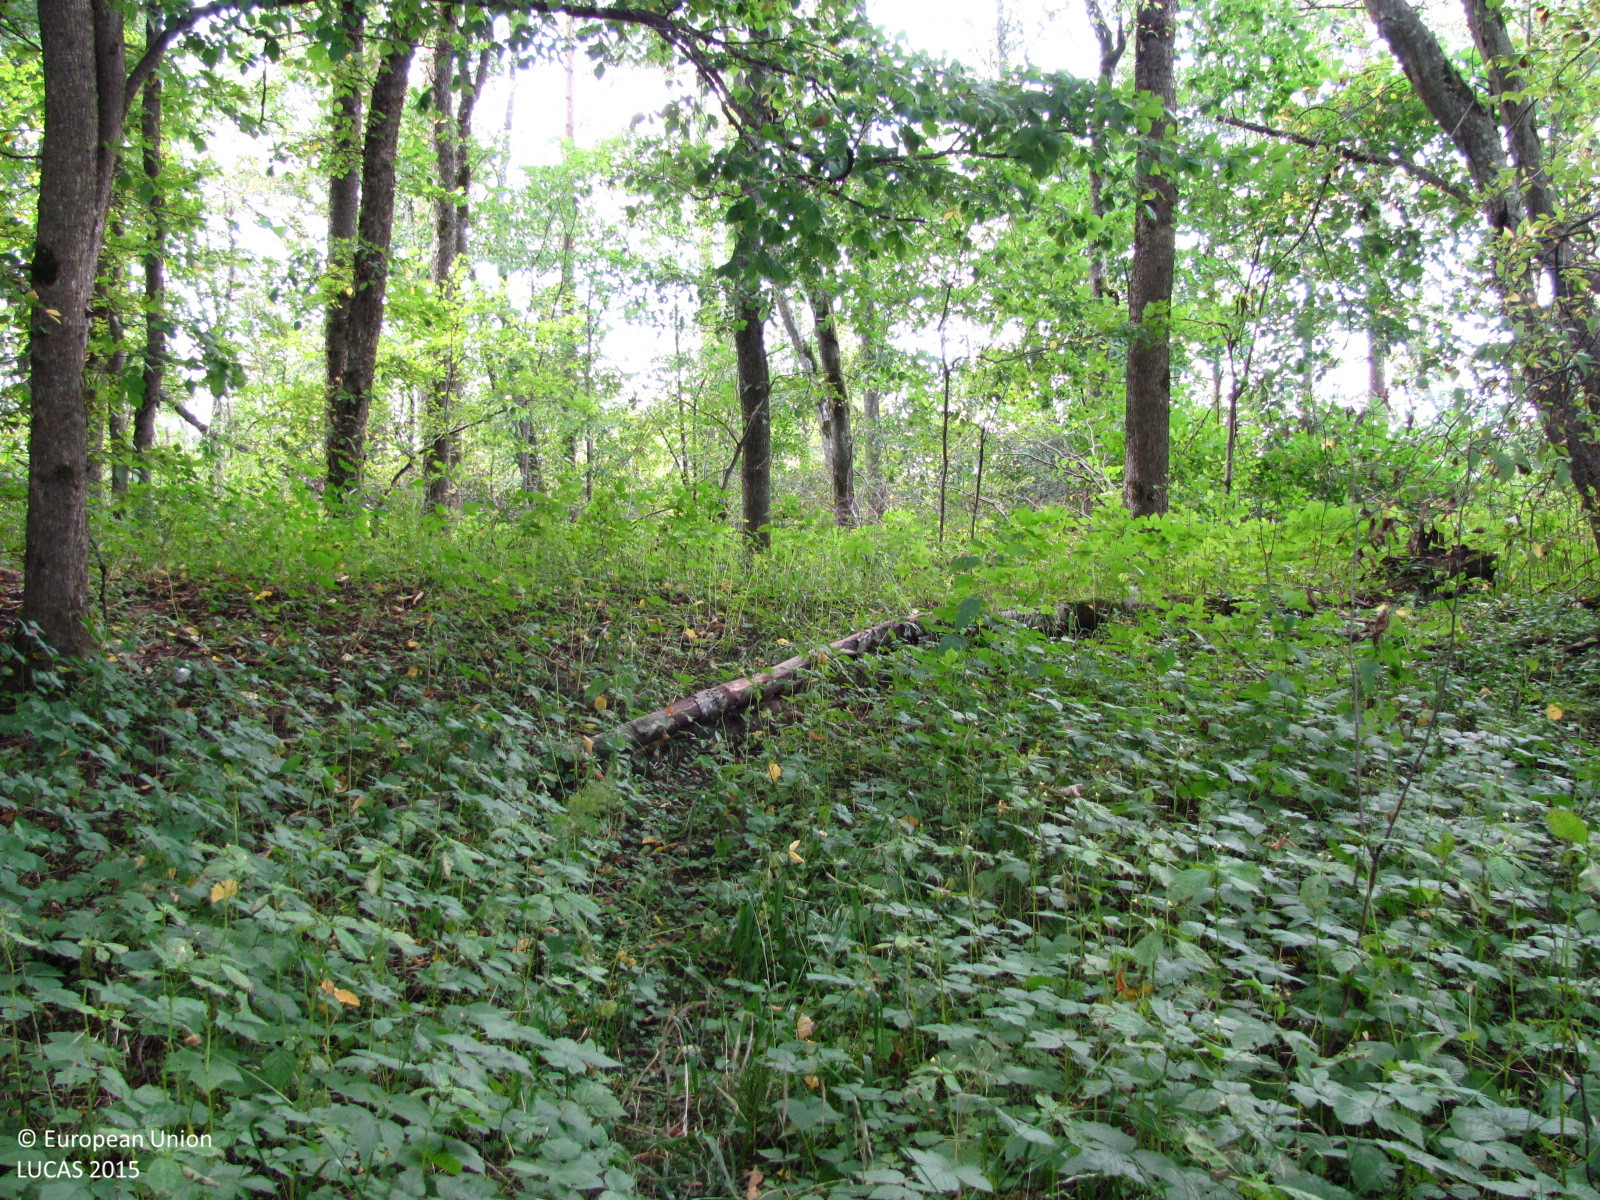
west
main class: Woodland
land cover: Broadleaved woodland
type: floodplain forest
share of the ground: > 75 %
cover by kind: broadleaved forest trees 80 %, herbaceous plants 15 %, unconsolidated bare surface 5 %
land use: Semi-natural and natural areas not in use
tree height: > 5 m
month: September
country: LV
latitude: 57.0975
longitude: 24.3341
